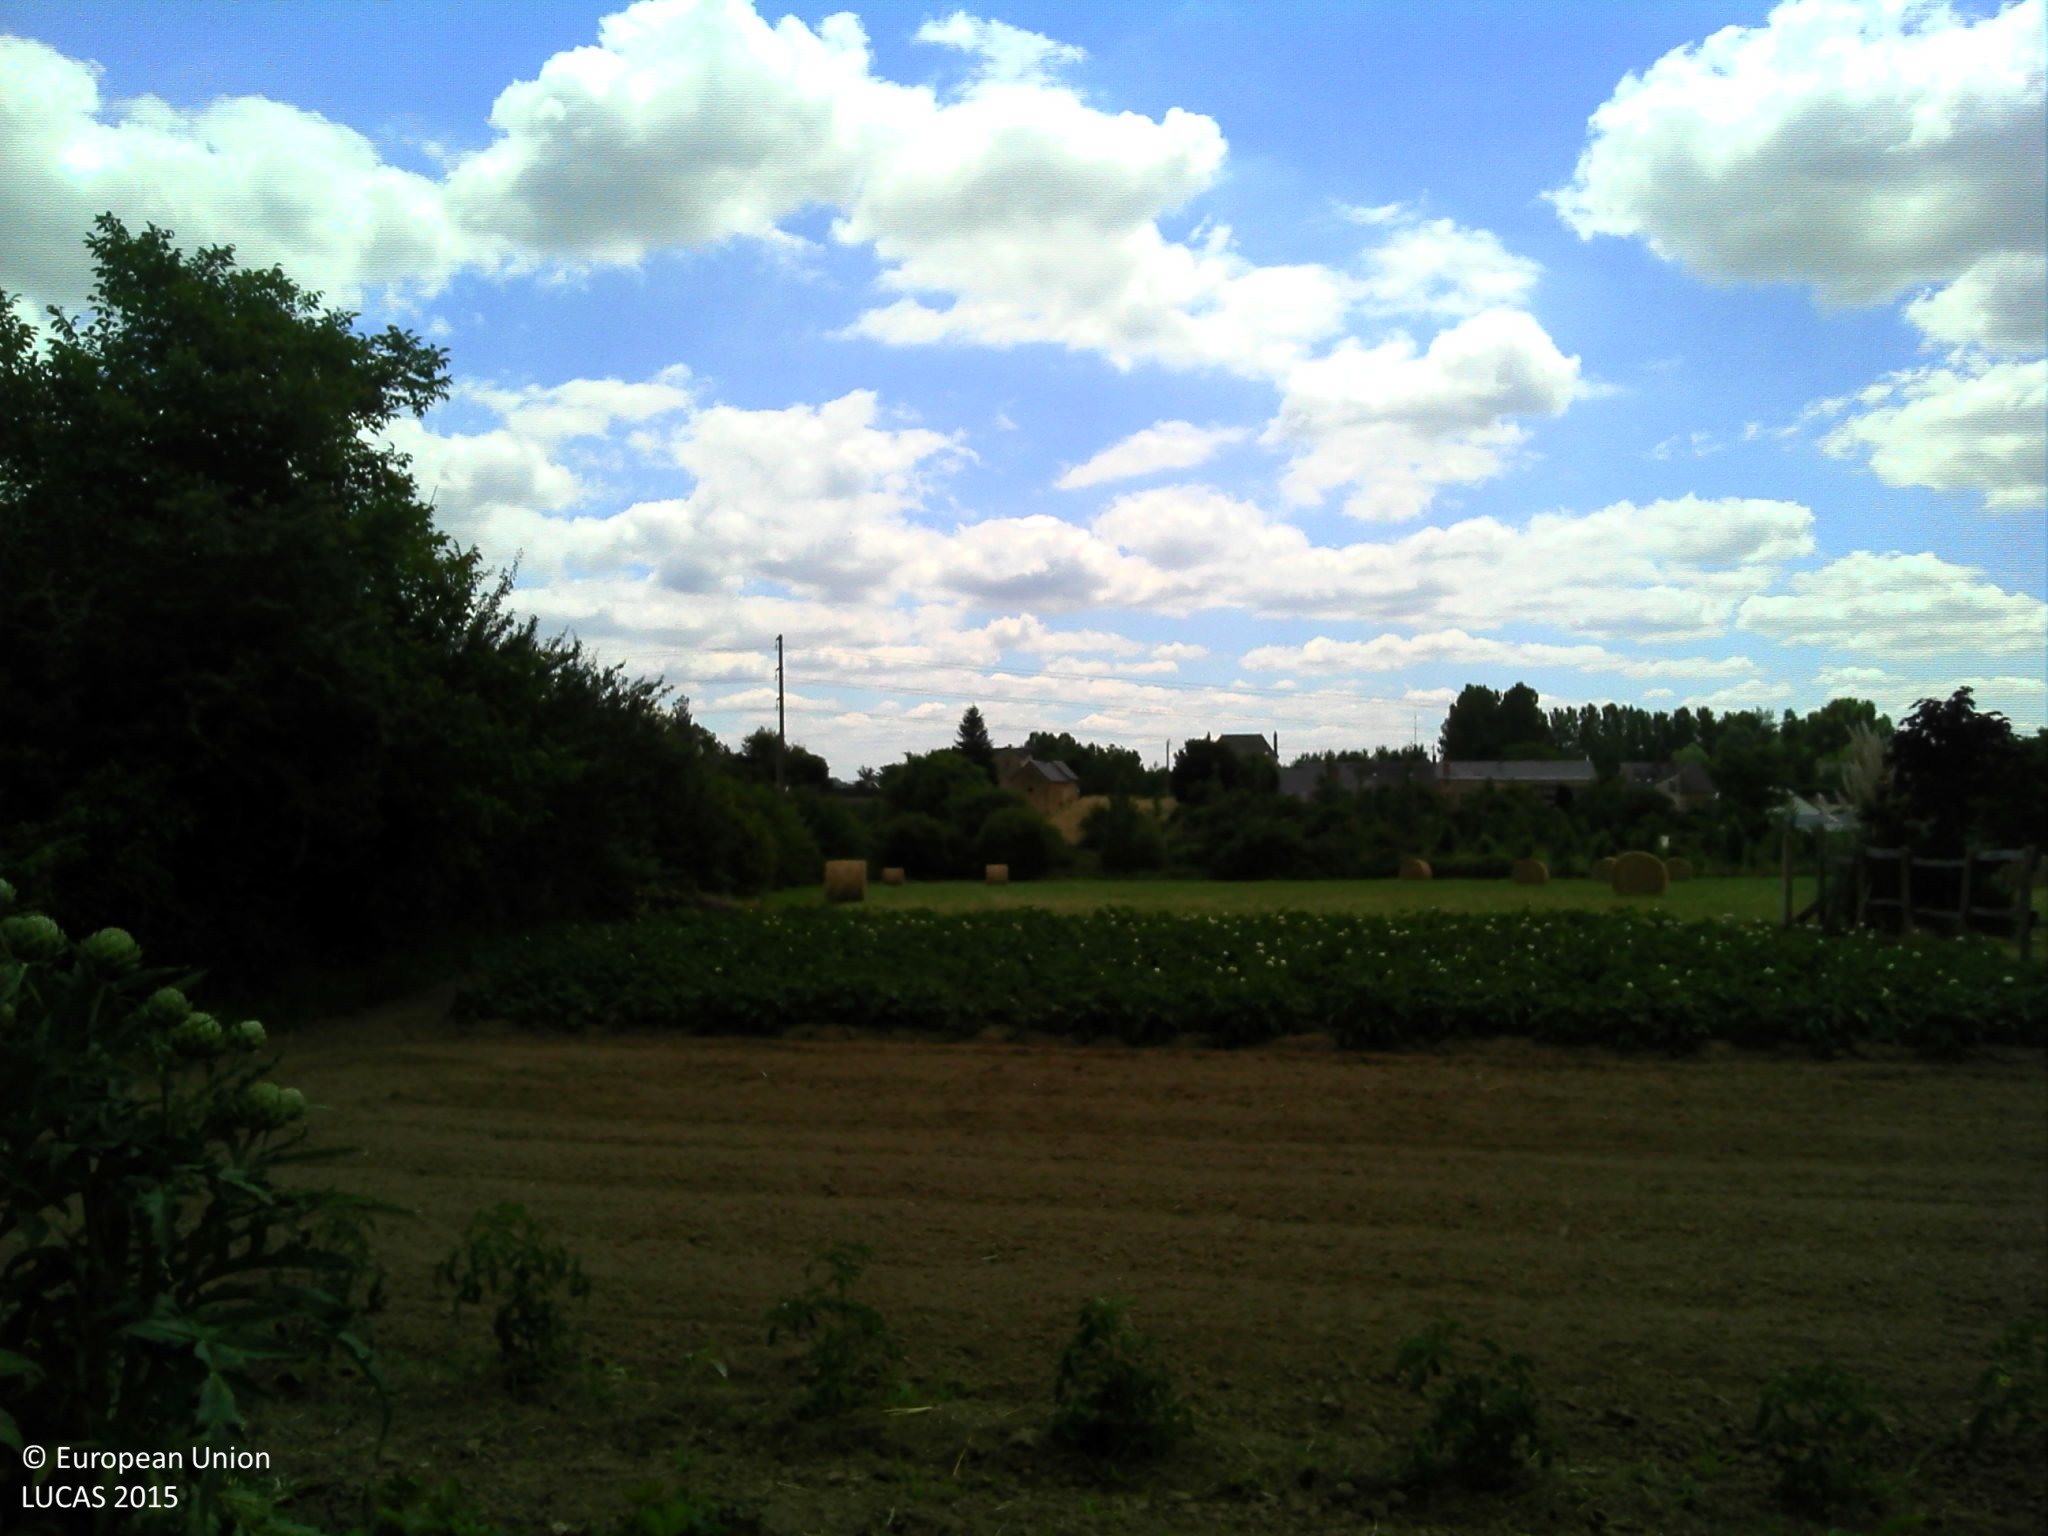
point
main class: Cropland
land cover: Potatoes
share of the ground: > 75 %
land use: Kitchen garden
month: June
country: FR
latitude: 47.8279
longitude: 0.2637
